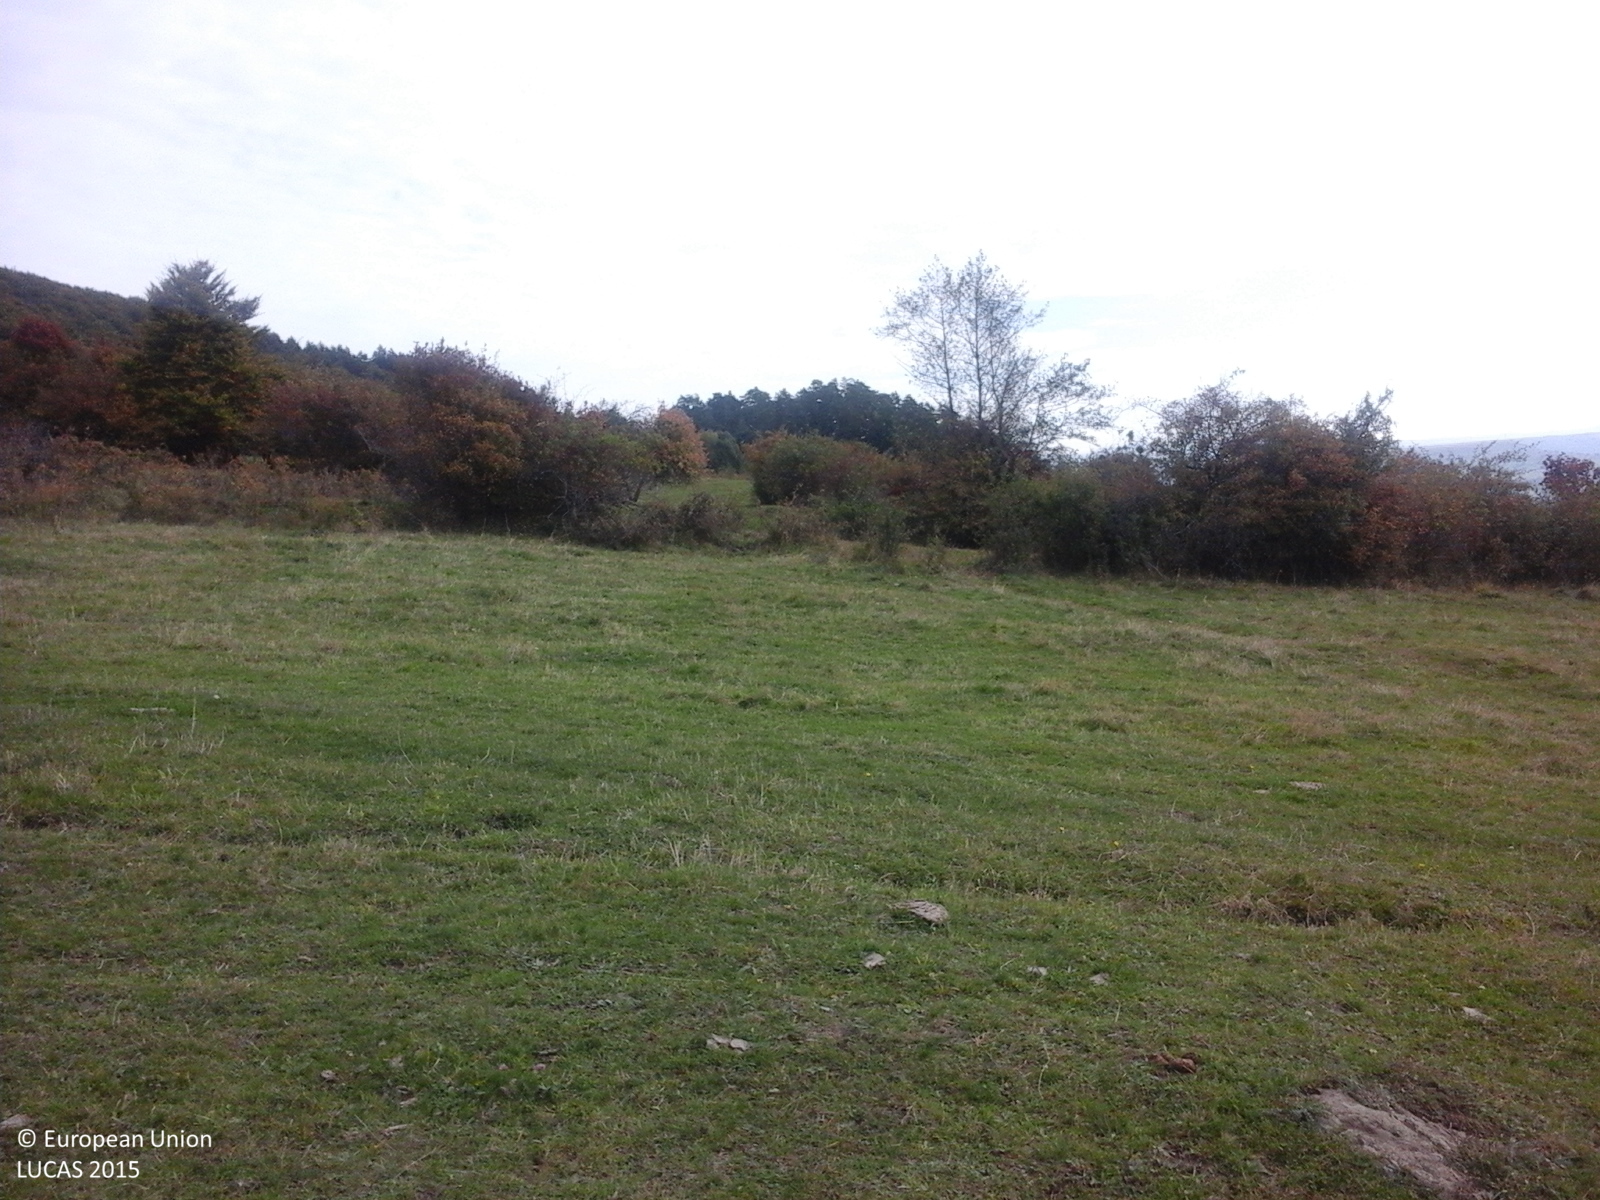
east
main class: Grassland
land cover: Grassland without tree/shrub cover
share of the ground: > 75 %
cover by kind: herbaceous plants 100 %
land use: Agriculture (excluding fallow land and kitchen gardens)
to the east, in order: Grassland without tree/shrub cover; Tracks; Grassland without tree/shrub cover; Shrubland without tree cover; Spontaneously vegetated surfaces
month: October
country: RO
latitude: 46.3991
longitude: 25.2813
